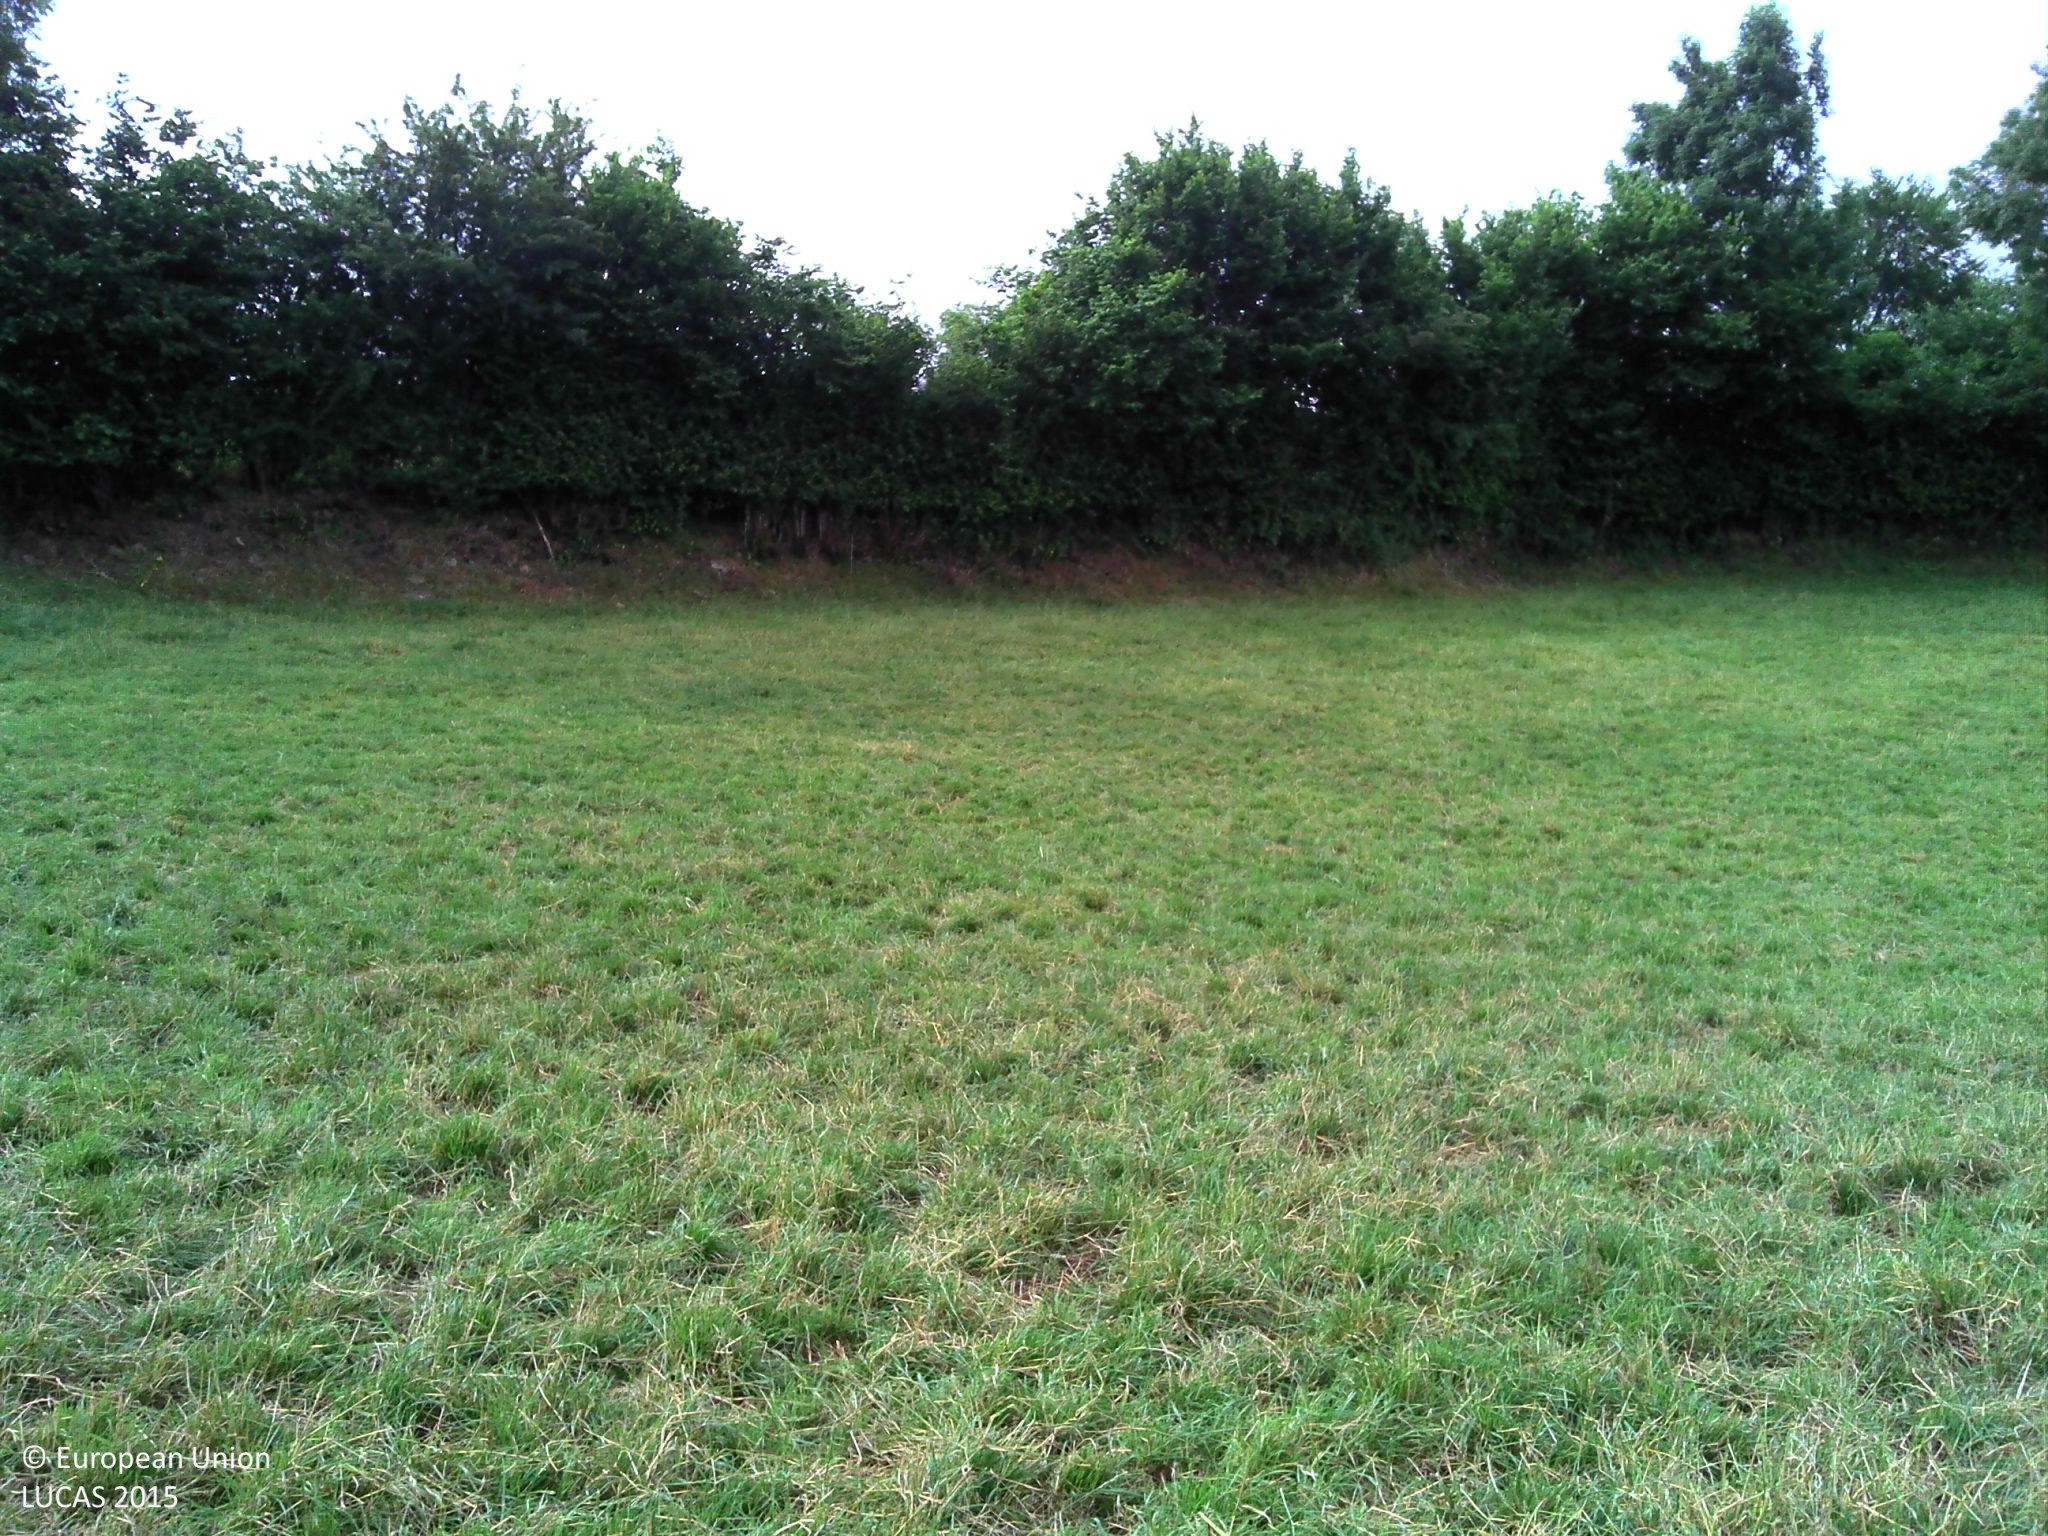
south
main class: Cropland
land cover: Temporary grasslands
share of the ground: > 75 %
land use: Agriculture (excluding fallow land and kitchen gardens)
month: June
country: FR
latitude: 44.2296
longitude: 2.5800
